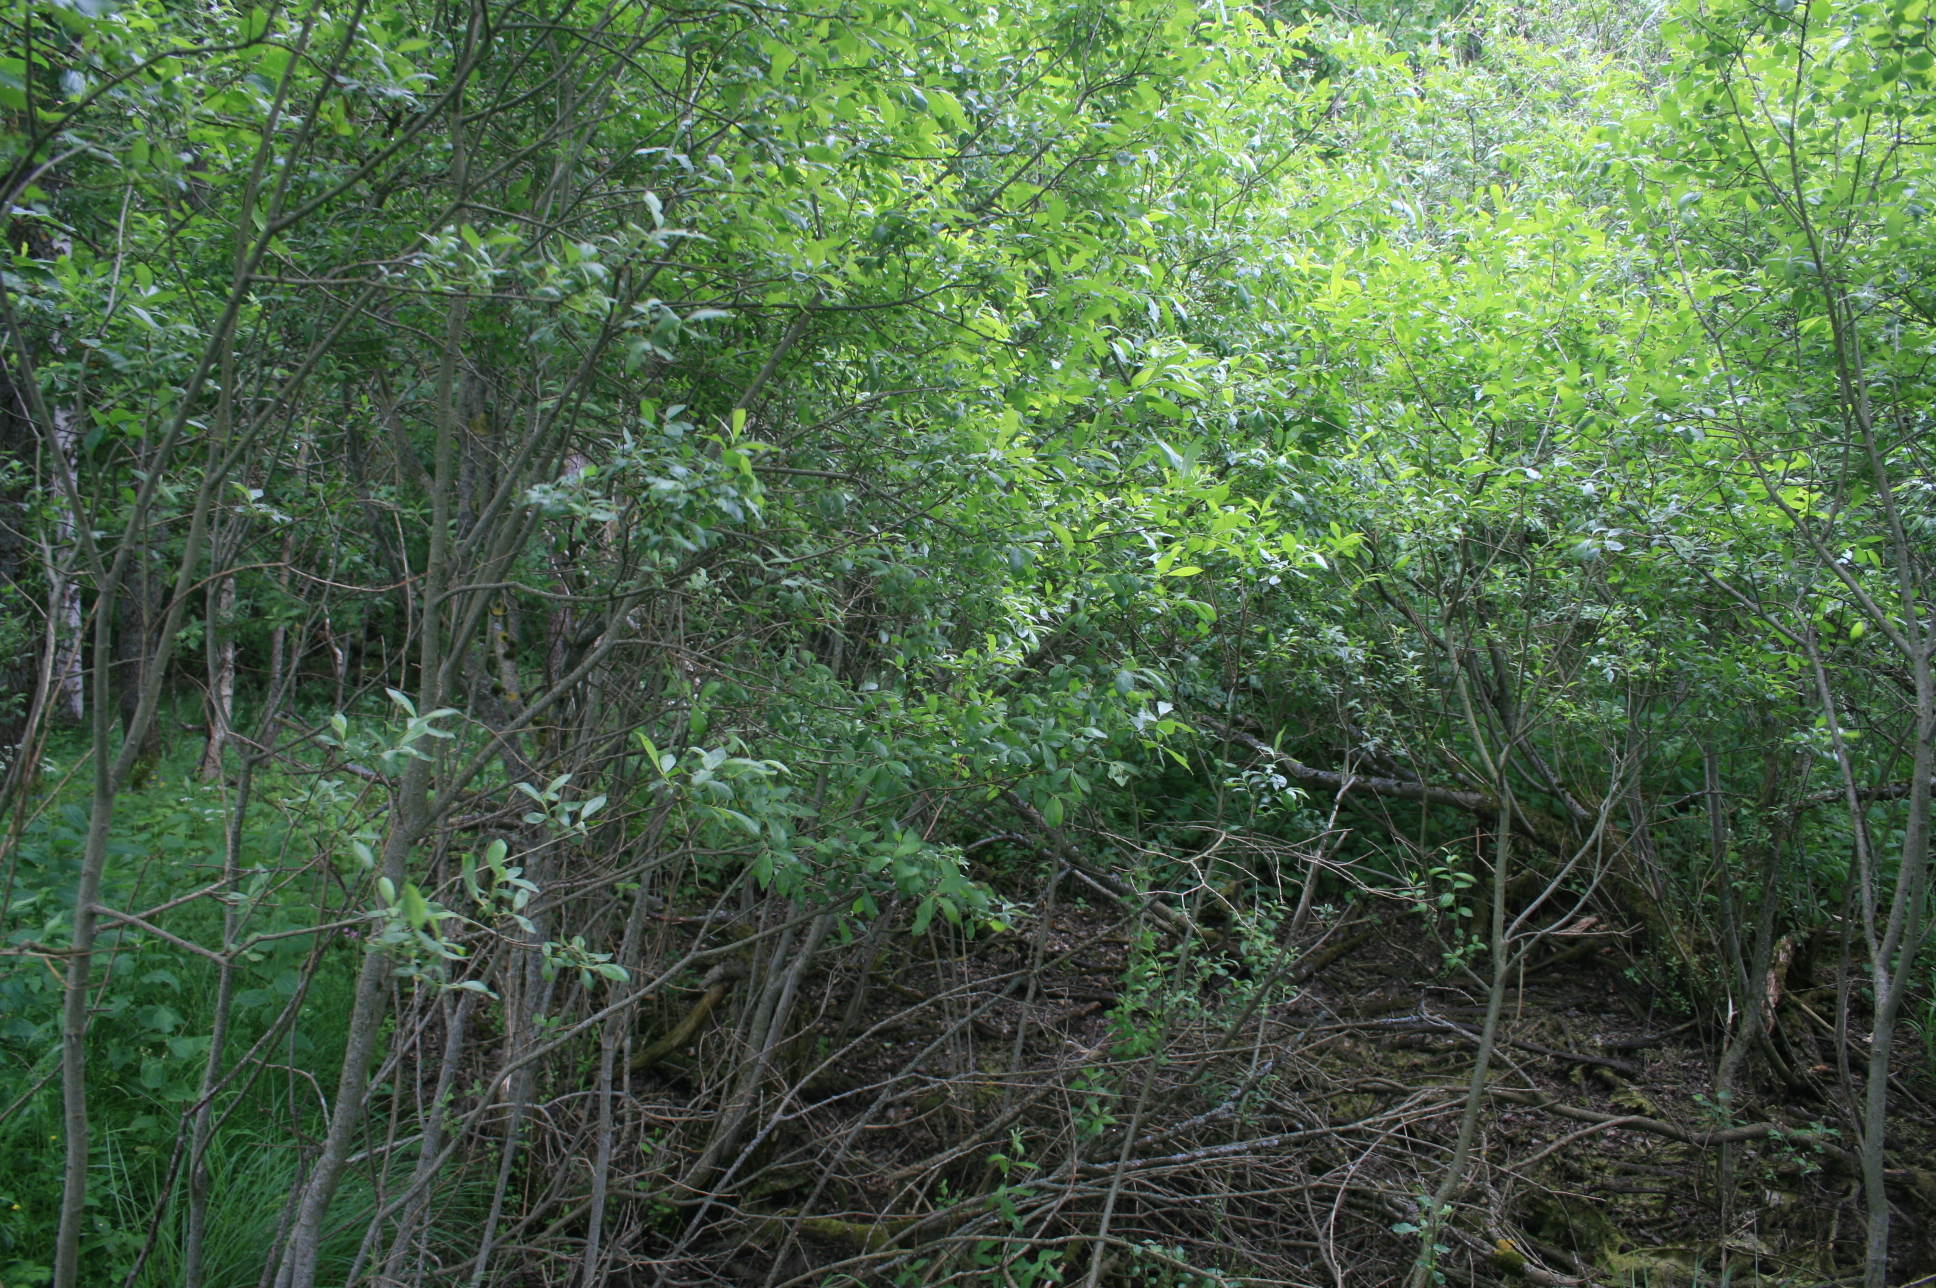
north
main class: Woodland
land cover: Broadleaved woodland
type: non-riverine alder, birch or aspen forest
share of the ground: > 75 %
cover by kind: broadleaved forest trees 80 %, shrubs 10 %, herbaceous plants 10 %
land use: Forestry
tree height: > 5 m
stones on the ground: < 10 %
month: June
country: LT
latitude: 55.6409
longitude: 22.3713
